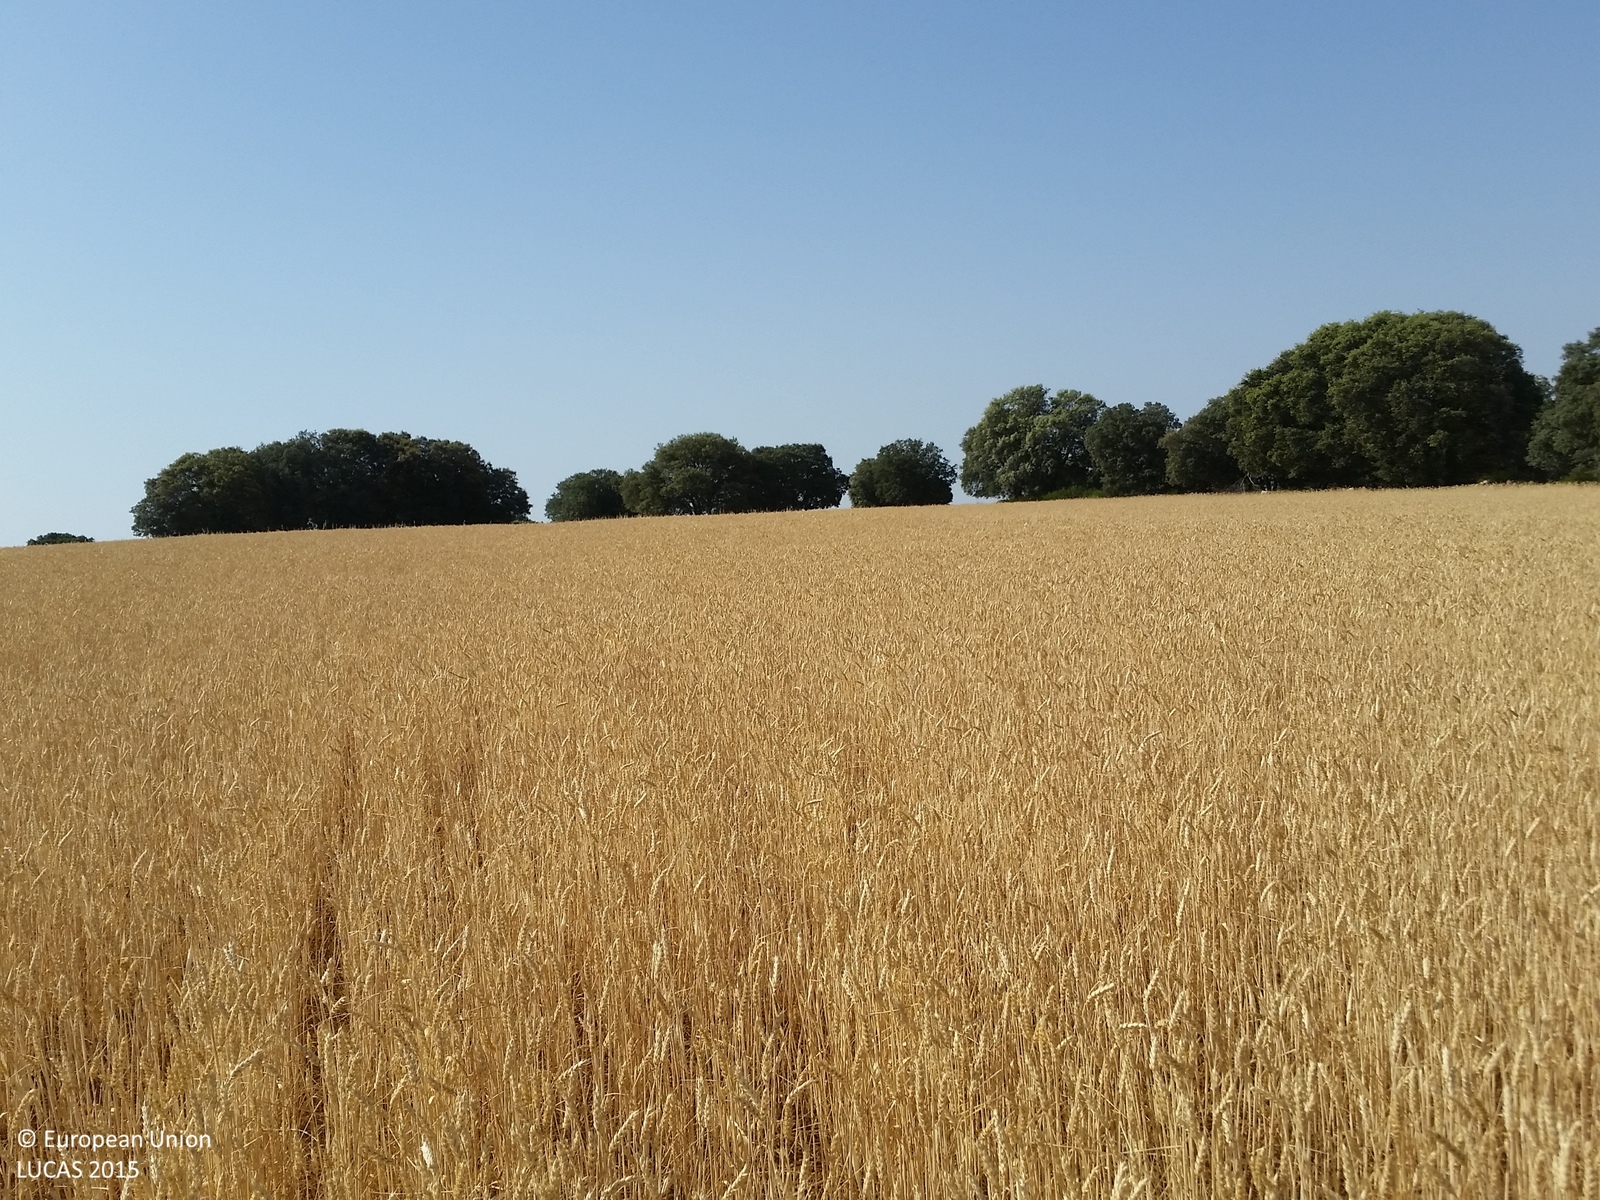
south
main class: Cropland
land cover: Common wheat
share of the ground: > 75 %
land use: Agriculture (excluding fallow land and kitchen gardens)
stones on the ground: < 10 %
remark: Harvested field
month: June
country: ES
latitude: 38.7378
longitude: -2.6003
